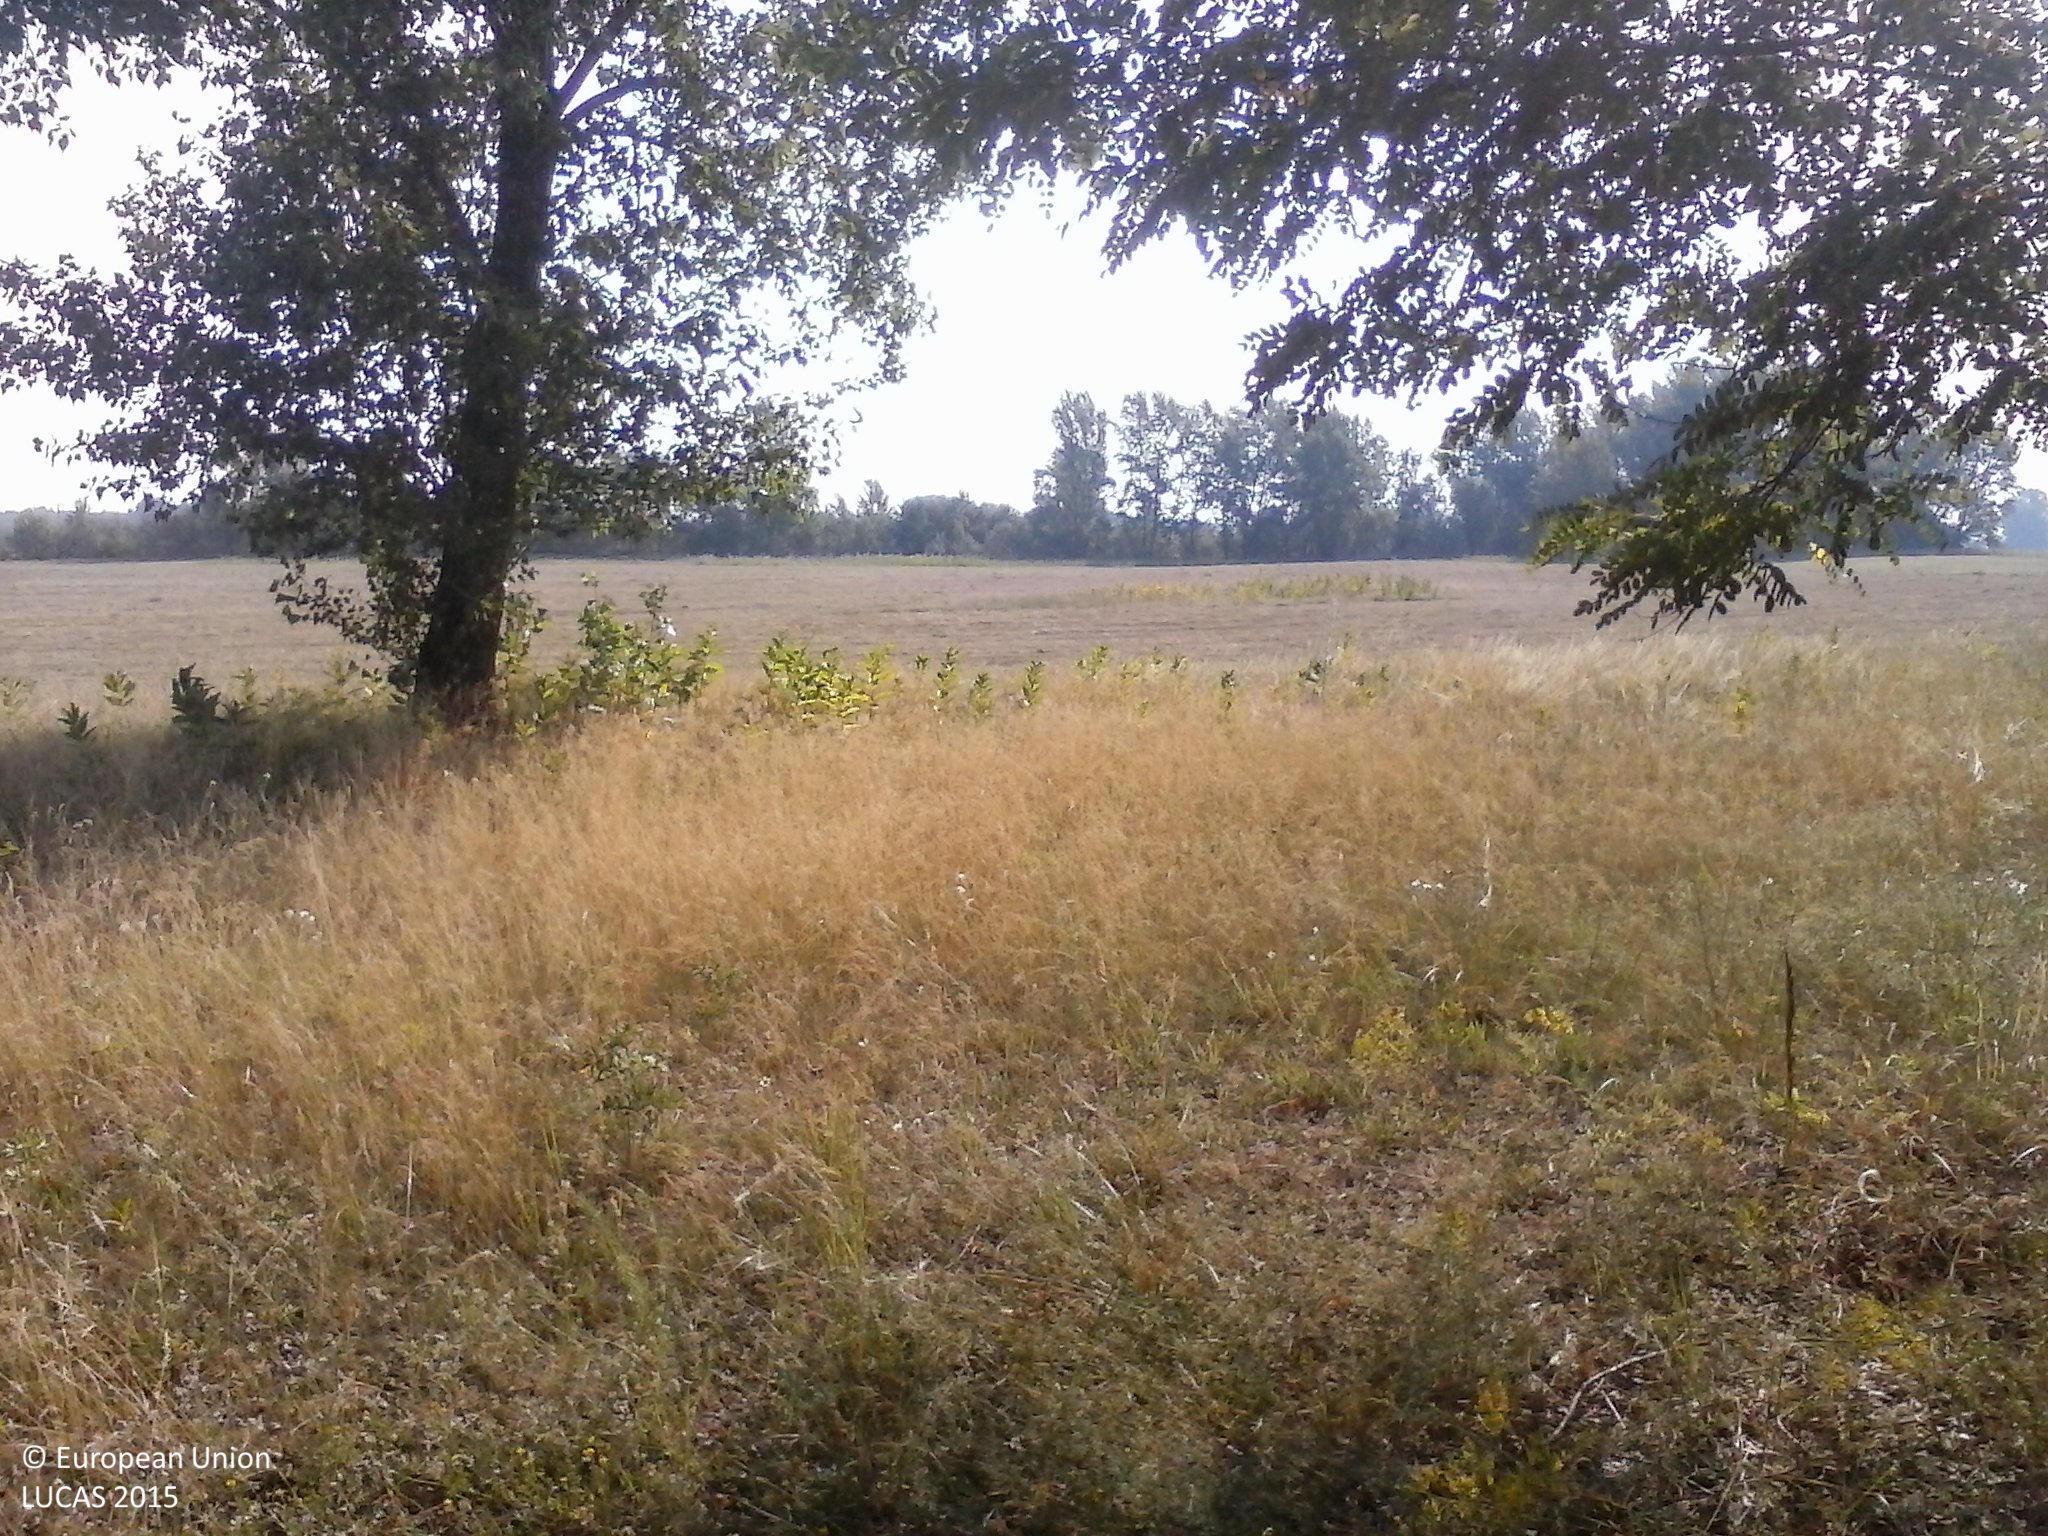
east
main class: Woodland
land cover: Broadleaved woodland
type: mesophytic deciduous forest
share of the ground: 25 - 50 %
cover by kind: herbaceous plants 70 %, broadleaved forest trees 25 %, shrubs 5 %
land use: Forestry
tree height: > 5 m
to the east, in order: Broadleaved woodland; Tracks; Grassland without tree/shrub cover; Spontaneously vegetated surfaces
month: July
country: HU
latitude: 46.4006
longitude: 19.6824
